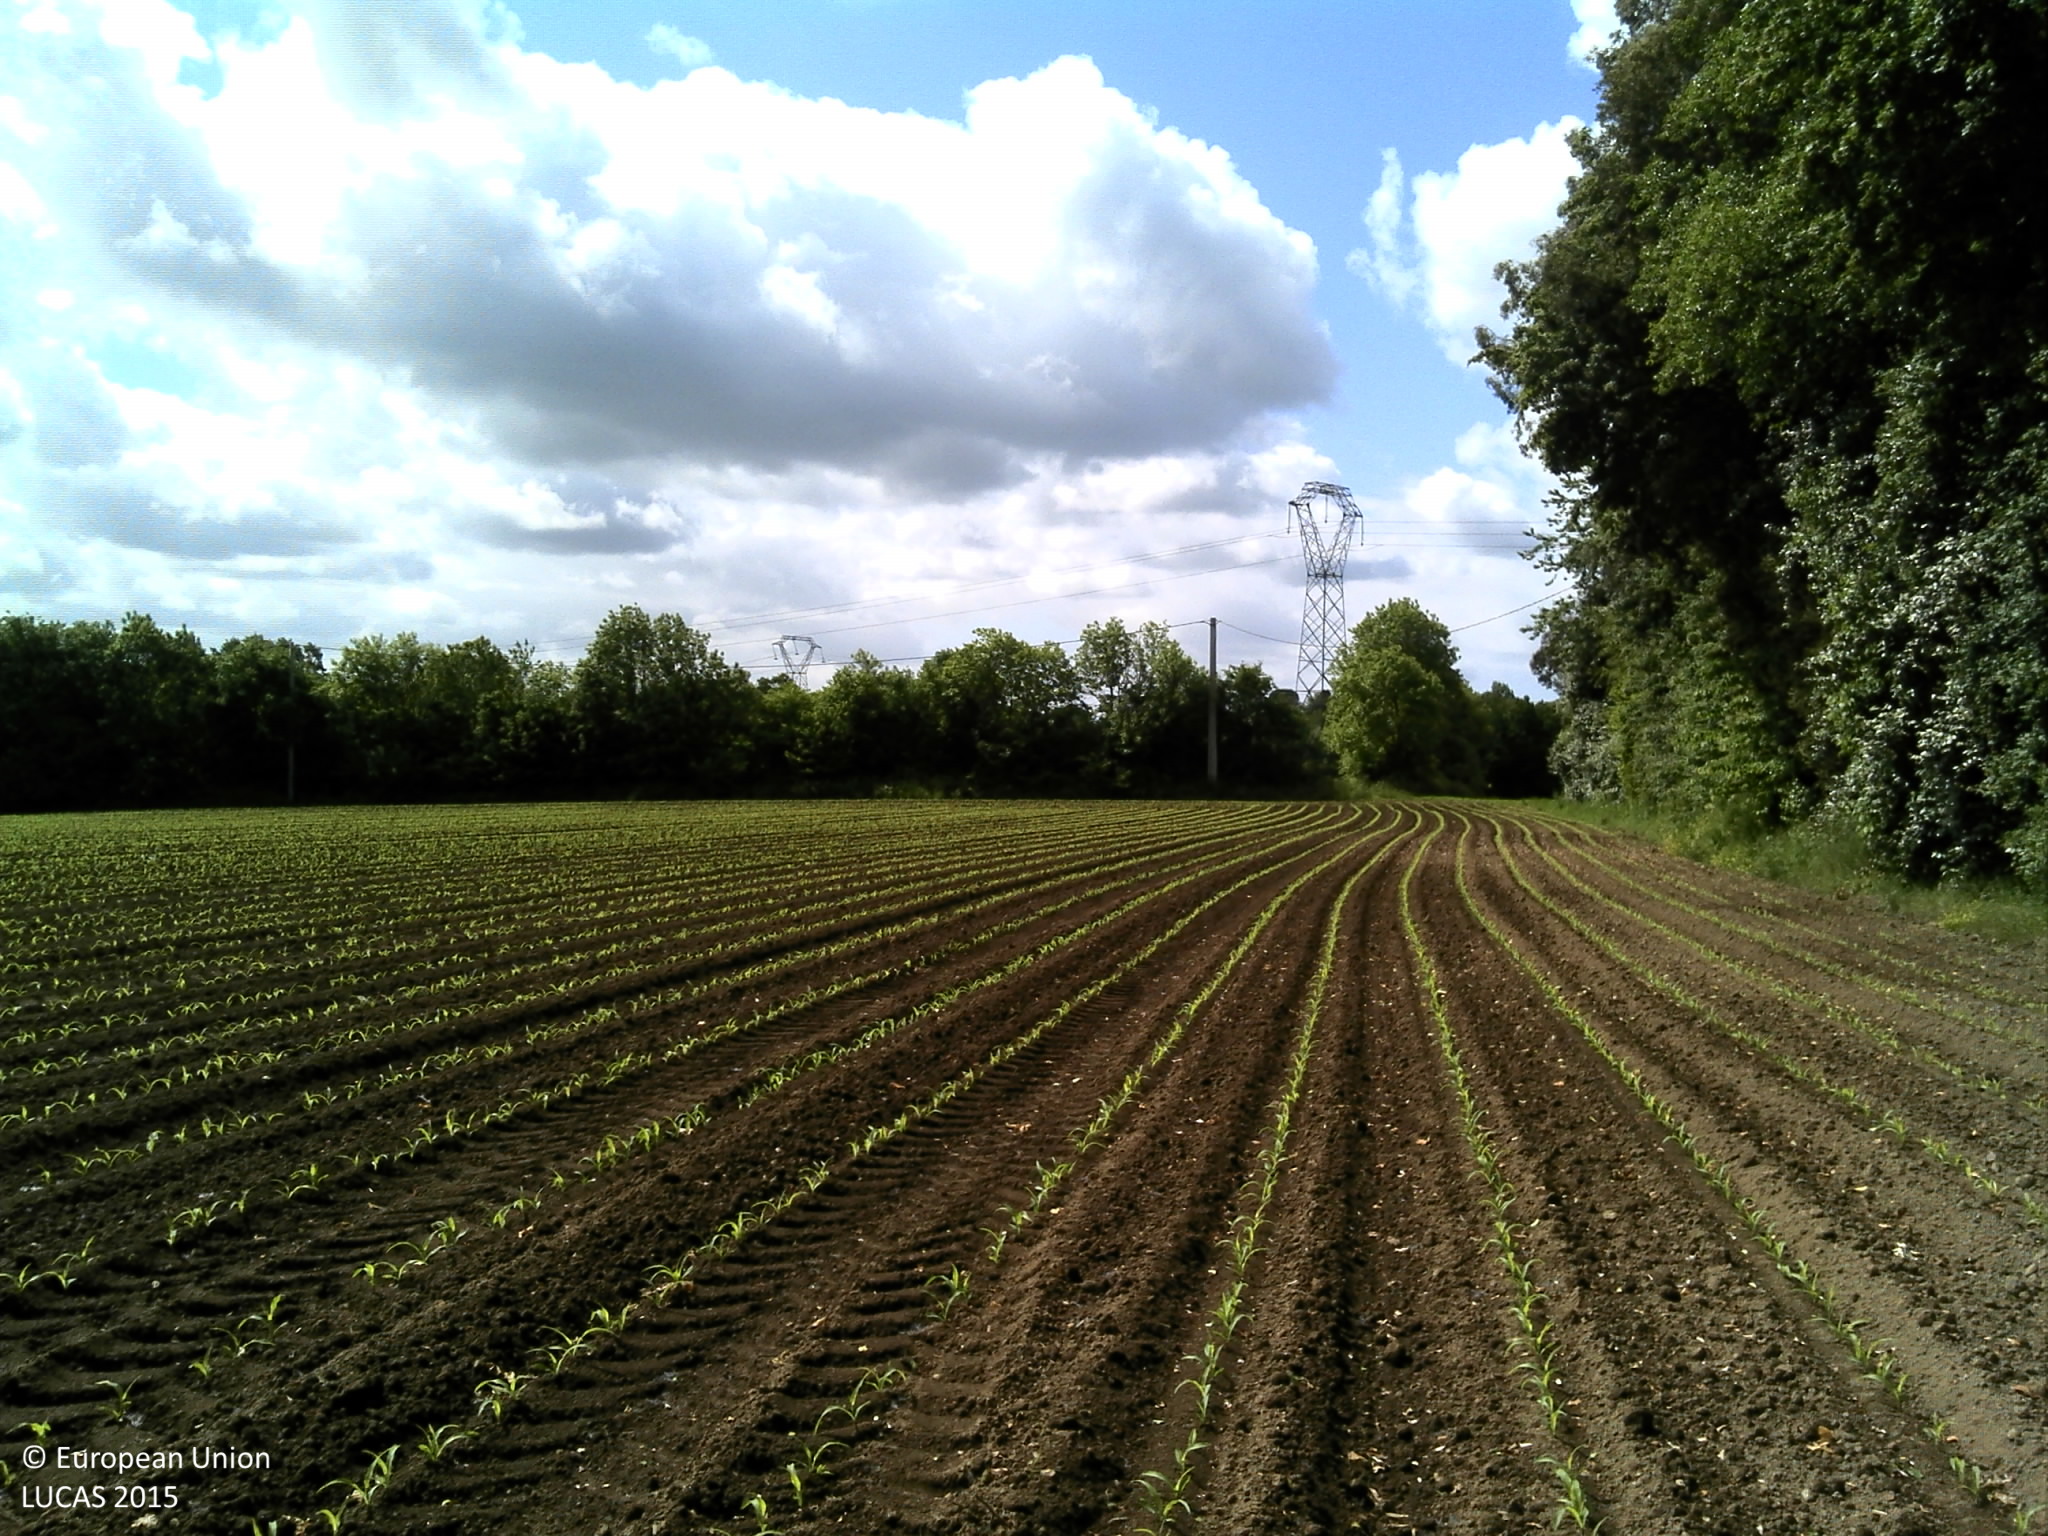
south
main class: Cropland
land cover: Maize
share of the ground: 10 - 25 %
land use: Agriculture (excluding fallow land and kitchen gardens)
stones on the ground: < 10 %
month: June
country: FR
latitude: 47.9145
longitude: -3.5240
